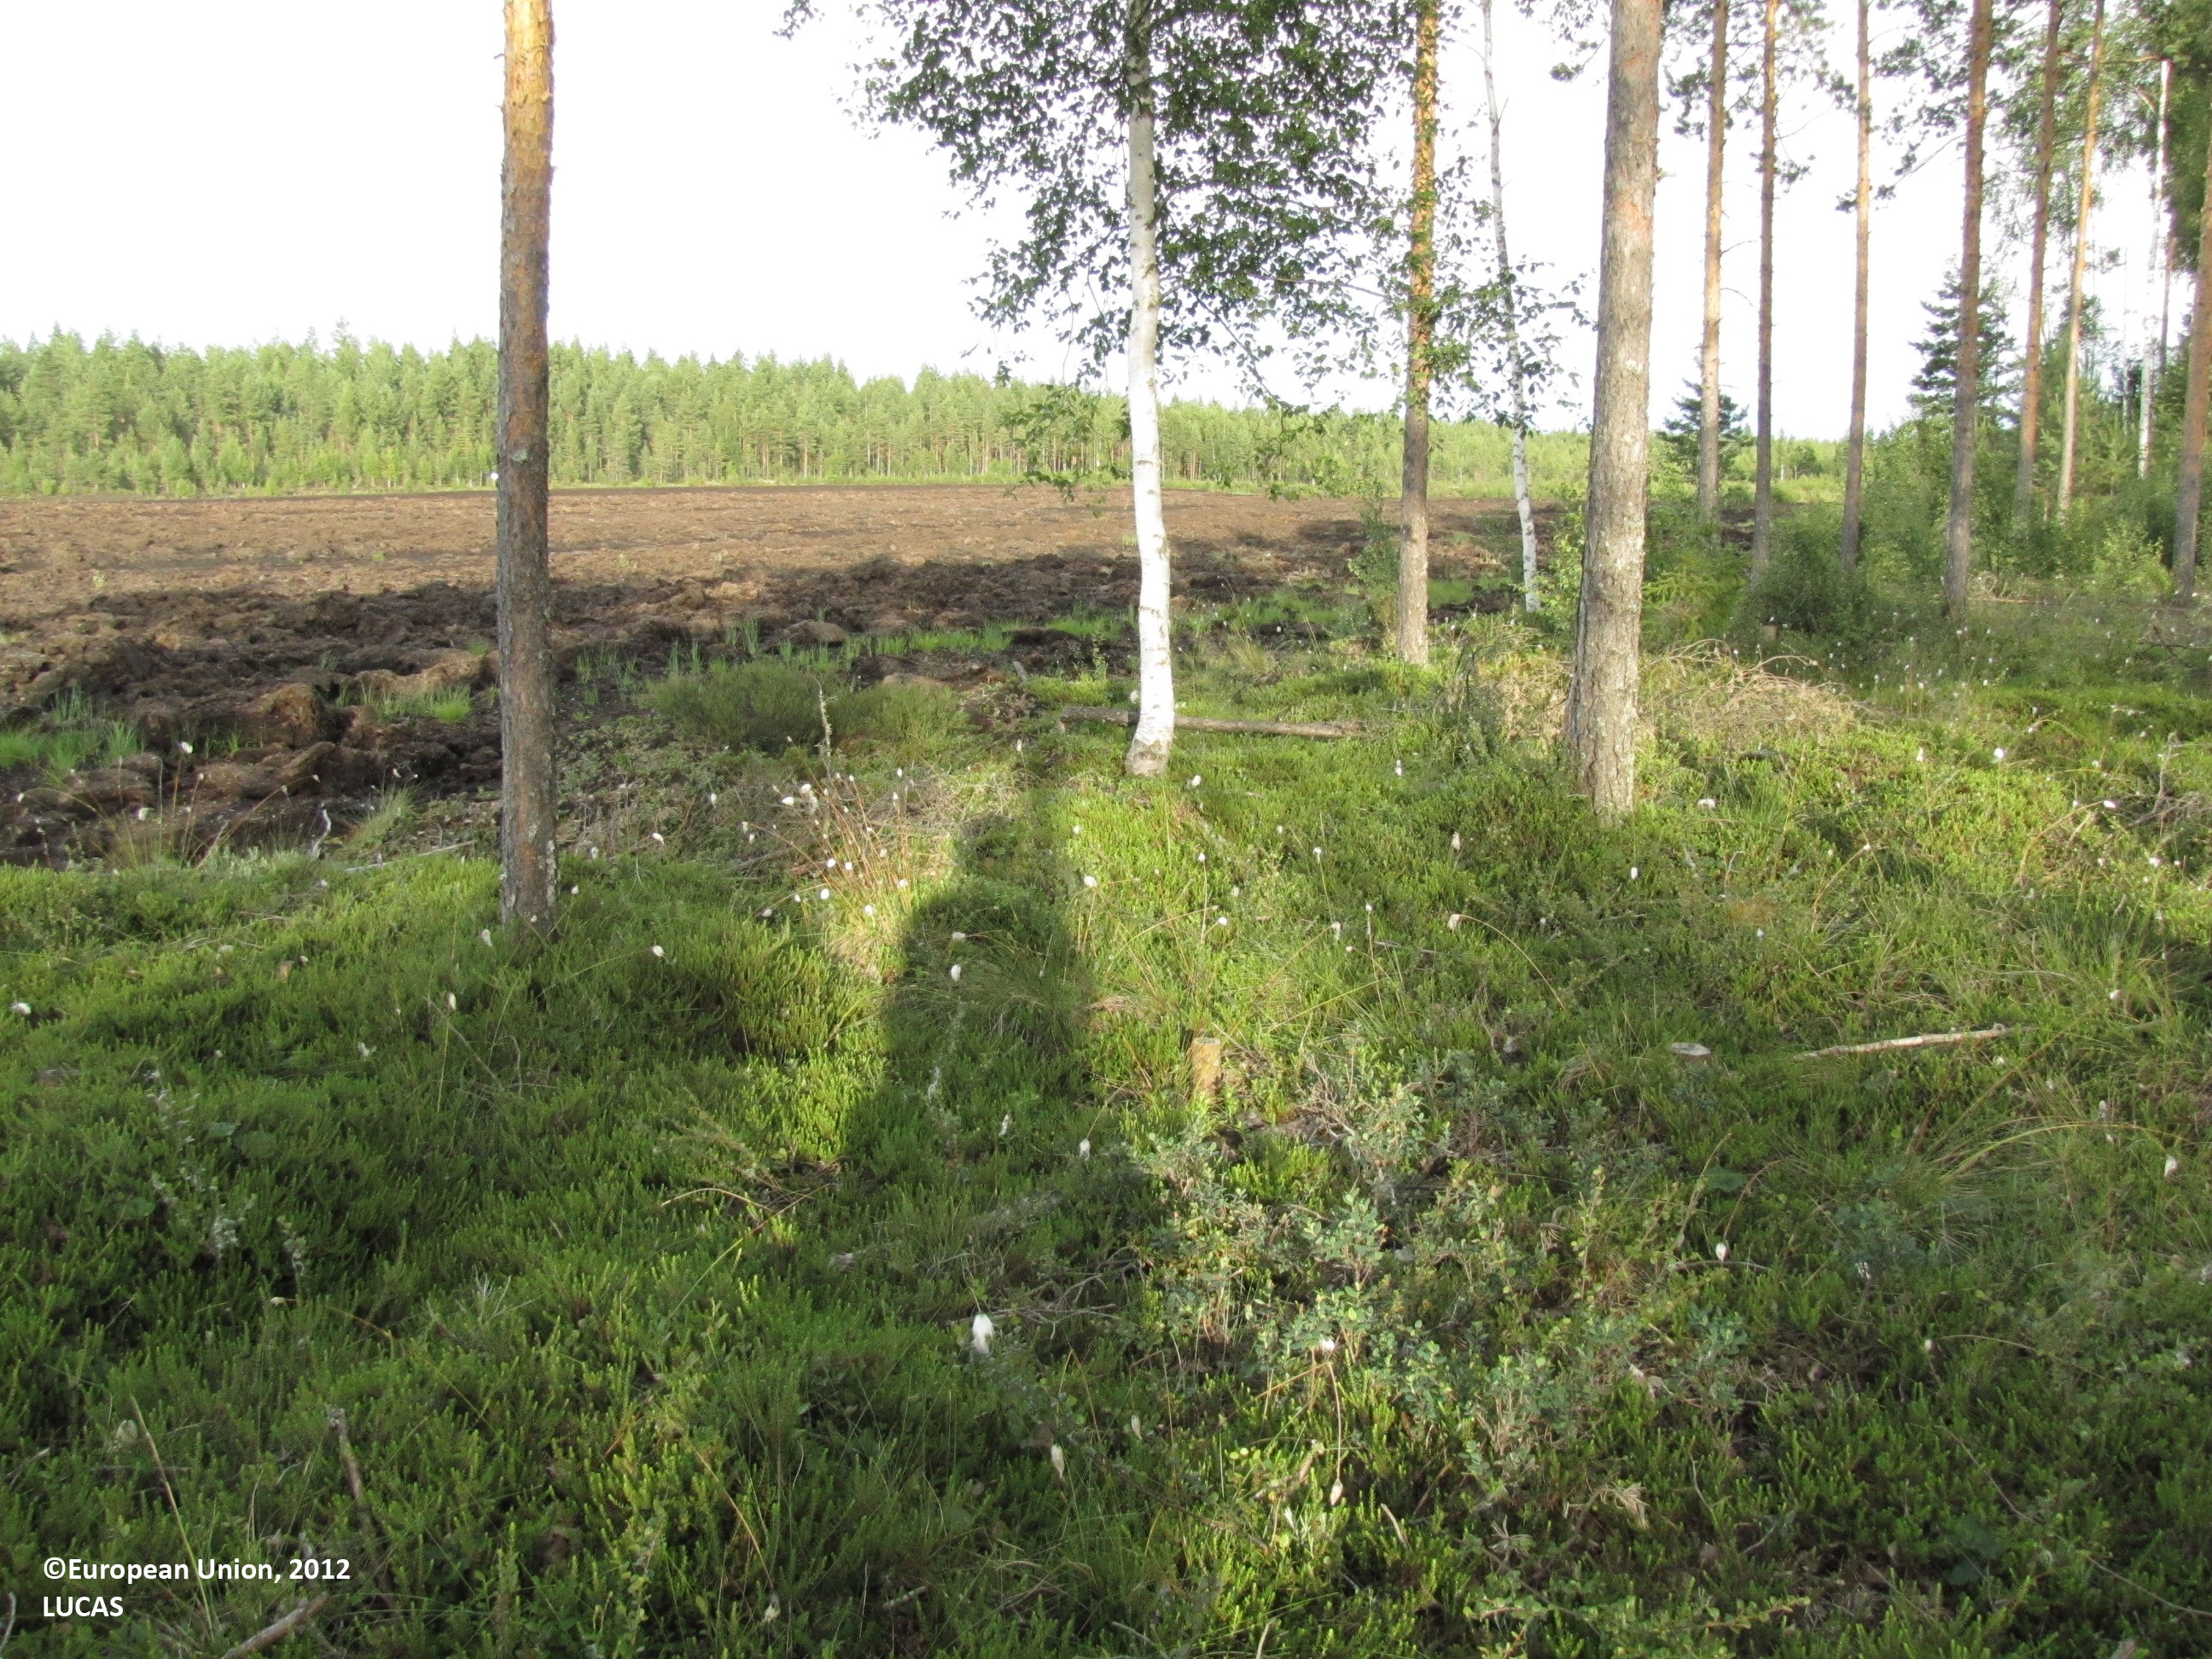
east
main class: Woodland
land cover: Pine dominated coniferous woodland
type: mire and swamp forests
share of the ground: 50 - 75 %
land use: Forestry
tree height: > 5 m
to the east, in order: Pine dominated coniferous woodland; Ditches and canals; Other bare soil; Ditches and canals; Other bare soil; Ditches and canals; Other bare soil; Ditches and canals; Other bare soil; Ditches and canals; Other bare soil; Ditches and canals; Other bare soil; Ditches and canals; Other bare soil; Ditches and canals; Pine dominated mixed woodland; Ditches and canals; Pine dominated coniferous woodland; Ditches and canals; Pine dominated coniferous woodland; Ditches and canals; Pine dominated coniferous woodland
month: July
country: FI
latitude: 62.4906
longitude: 23.5597
